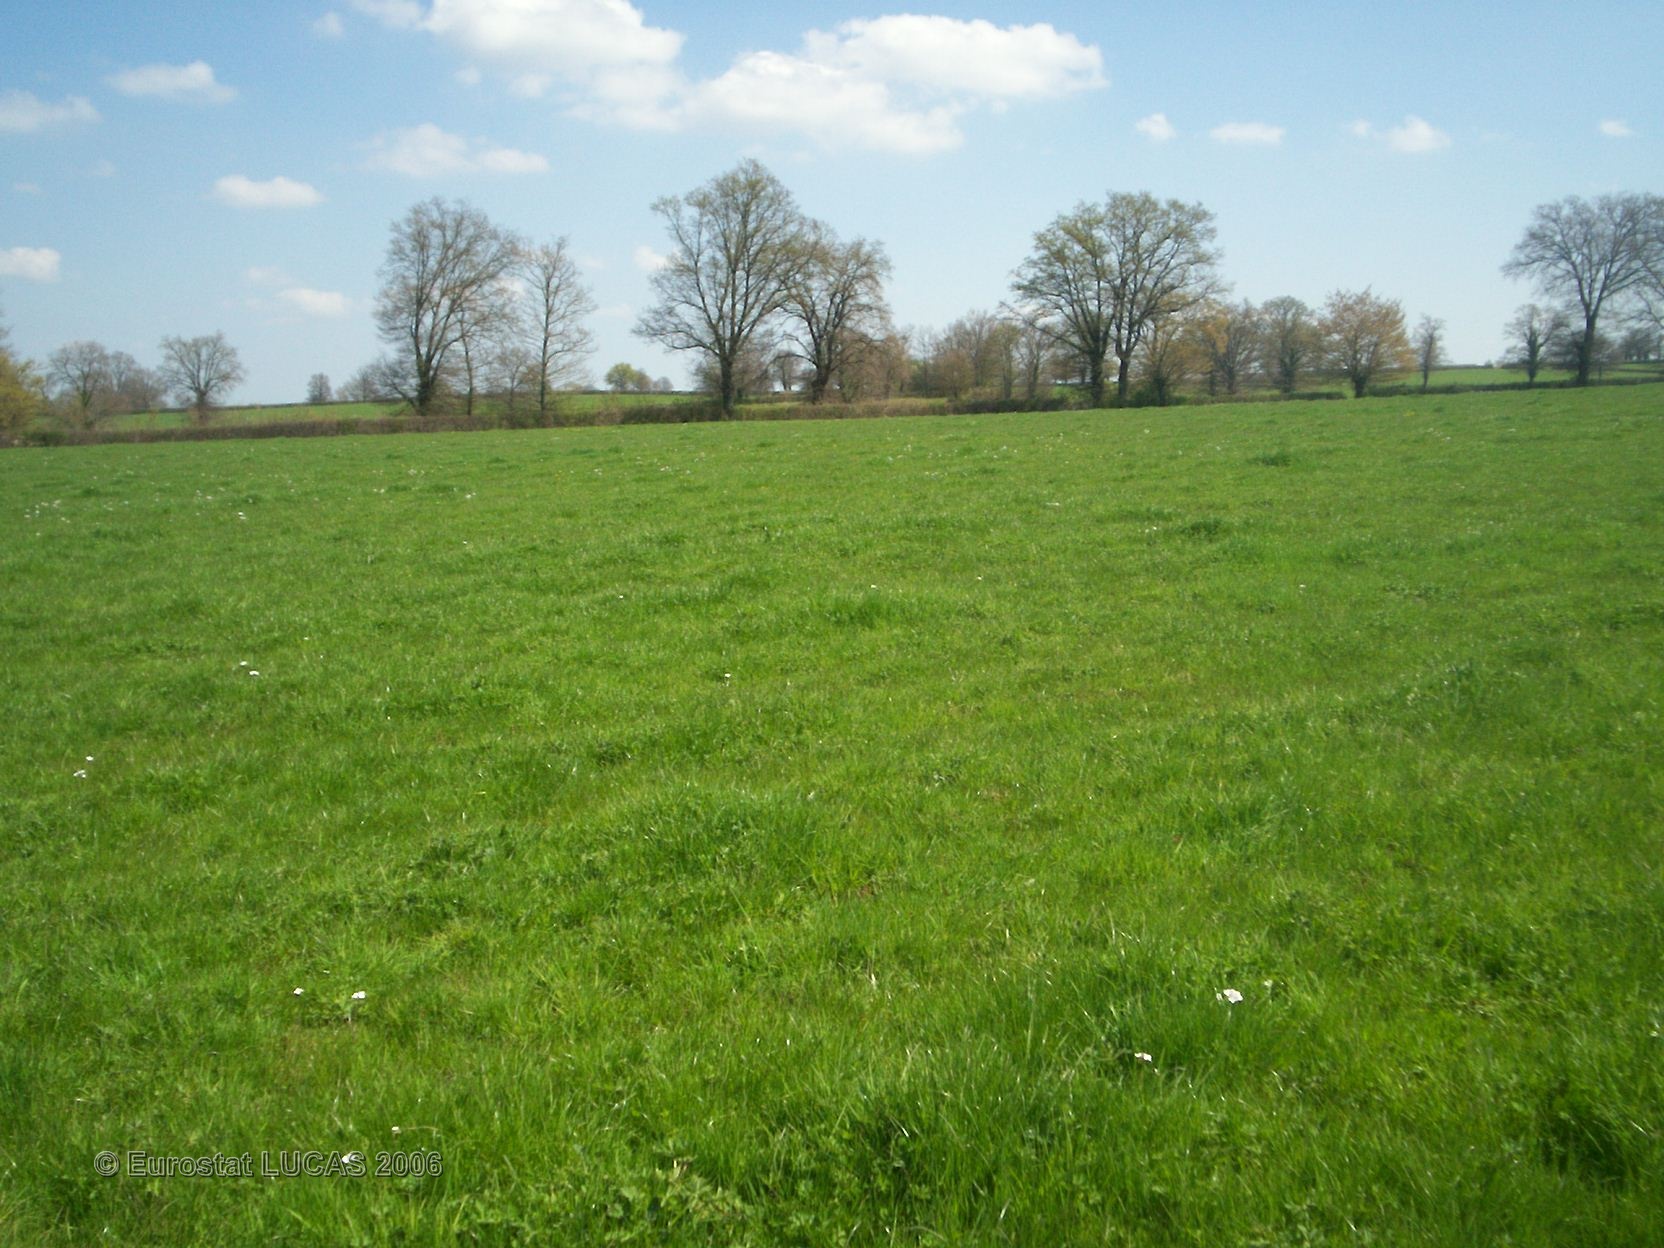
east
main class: Grassland
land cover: Grassland without tree/shrub cover
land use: Agriculture (excluding fallow land and kitchen gardens)
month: April
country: FR
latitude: 46.6514
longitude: 3.0848
